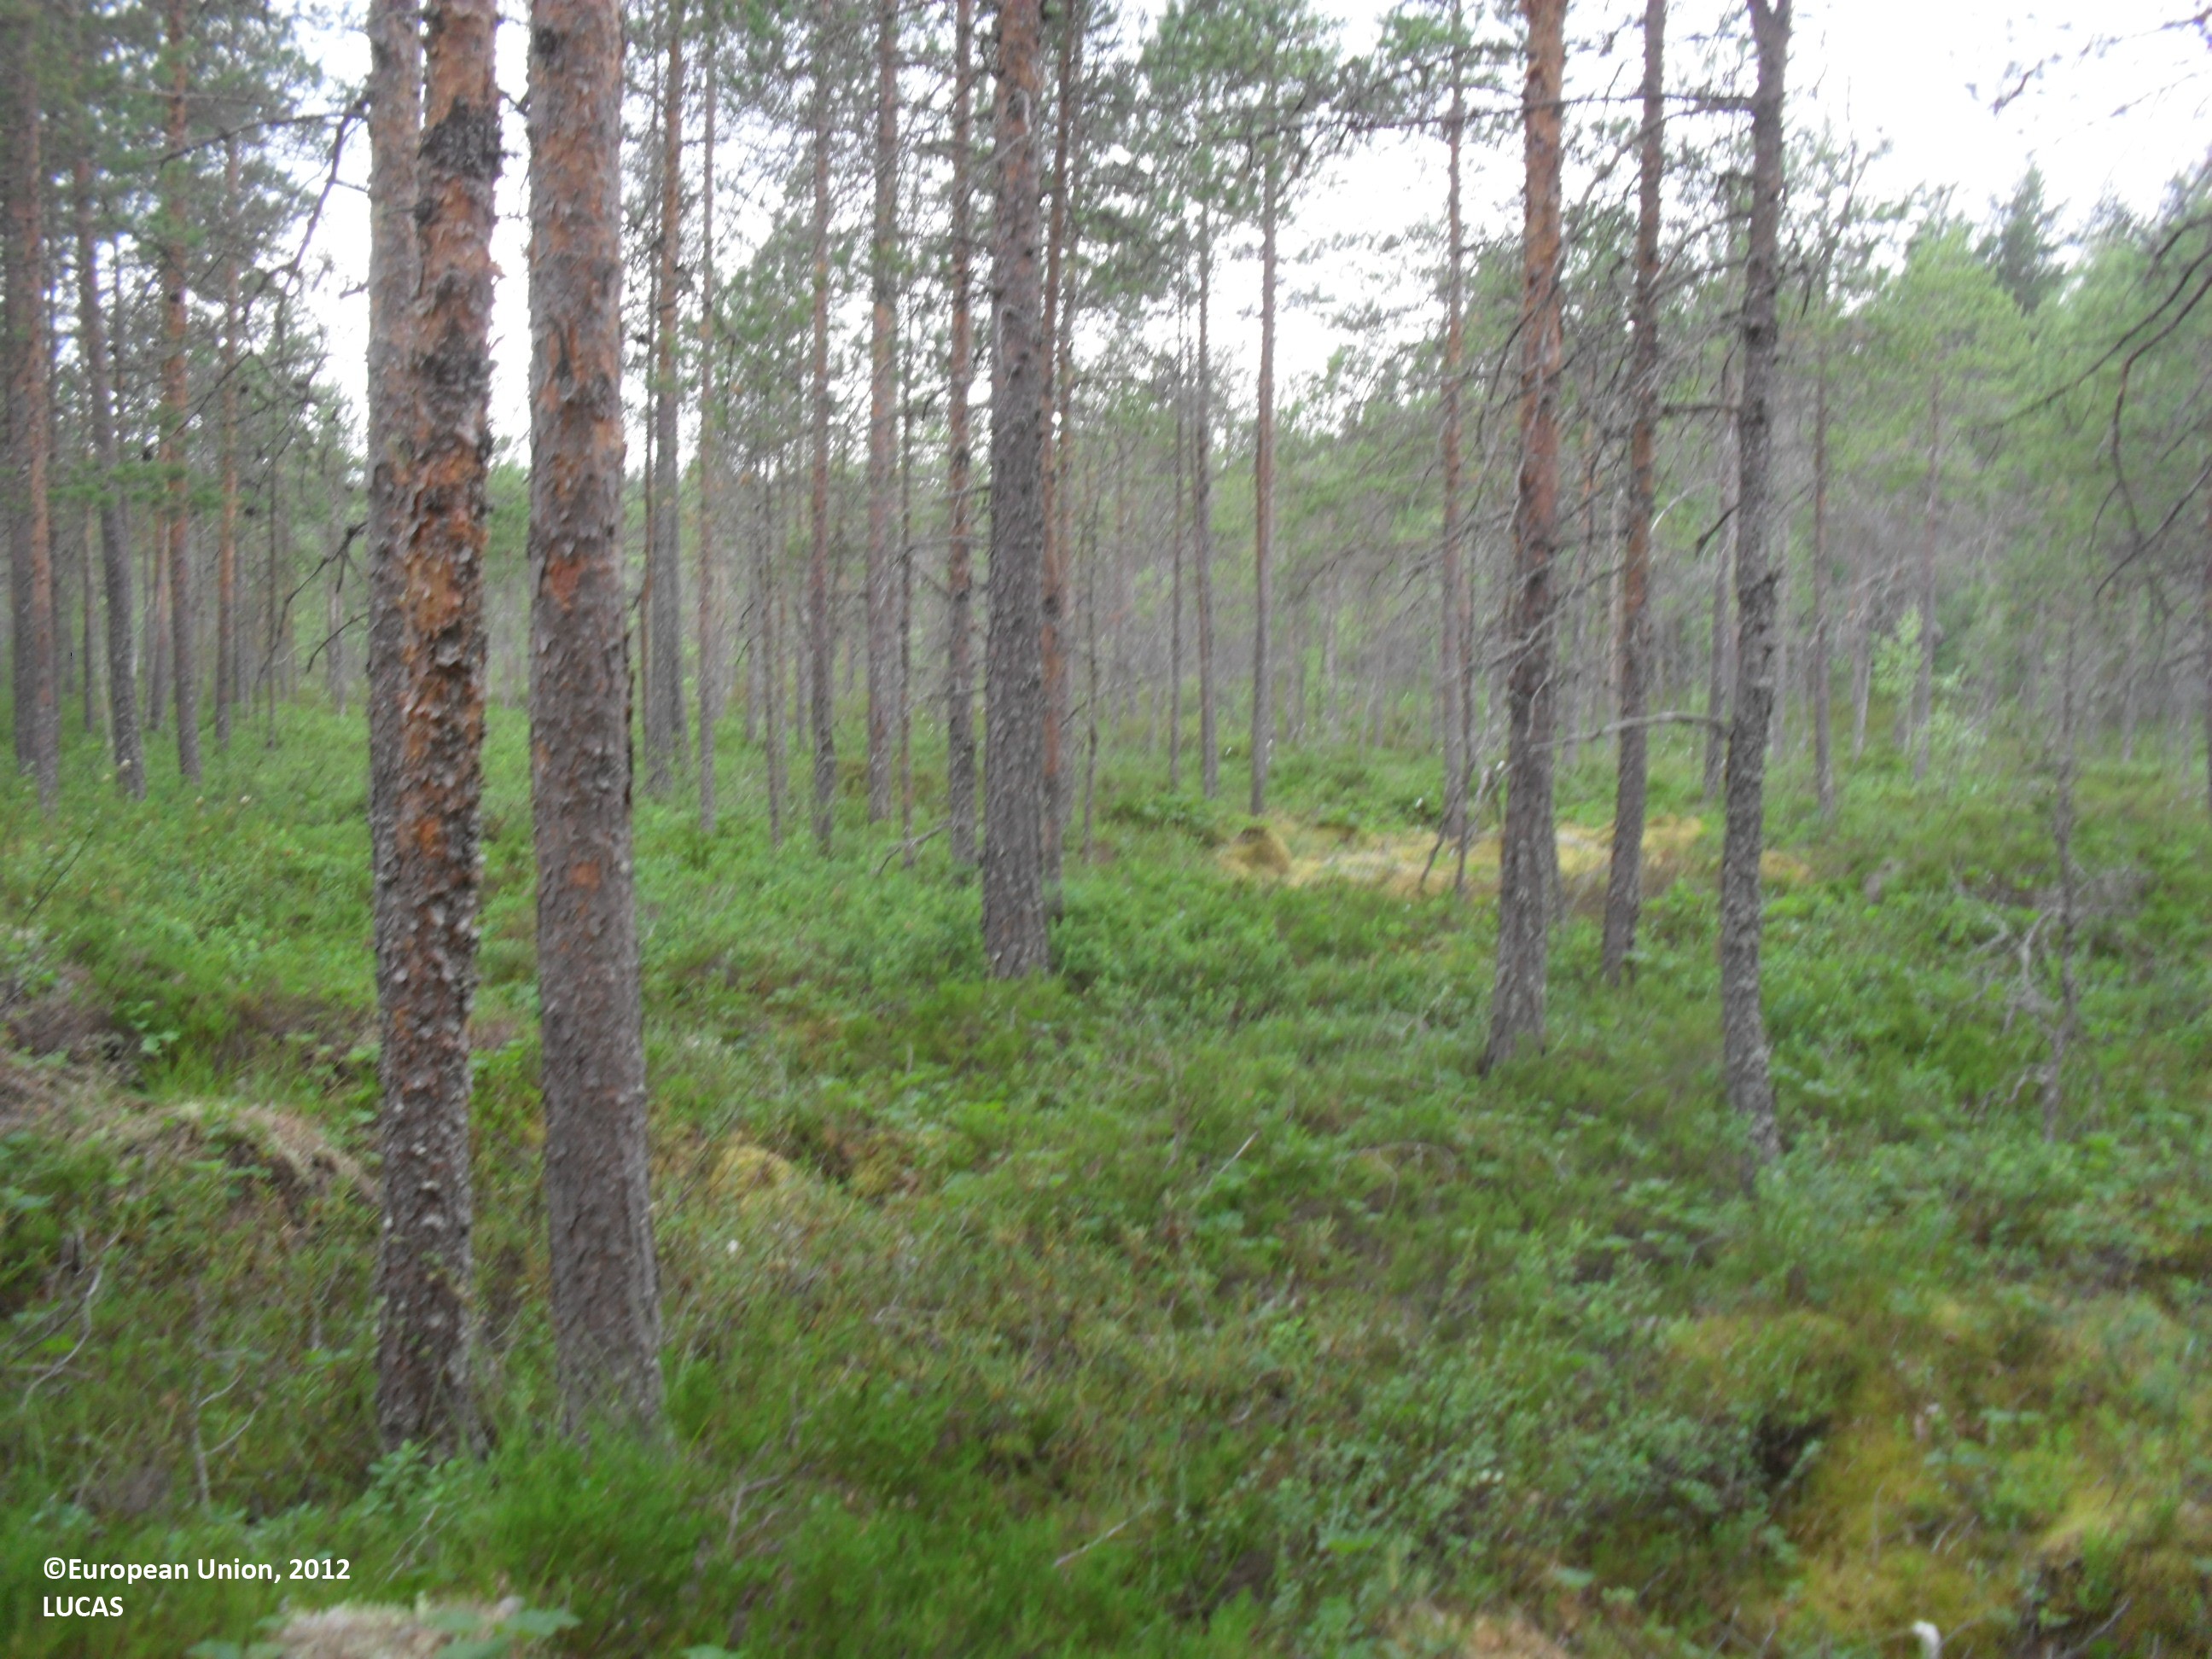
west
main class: Woodland
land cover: Pine dominated coniferous woodland
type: mire and swamp forests
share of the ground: 25 - 50 %
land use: Forestry
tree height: > 5 m
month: July
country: FI
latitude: 63.5760
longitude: 23.5363
